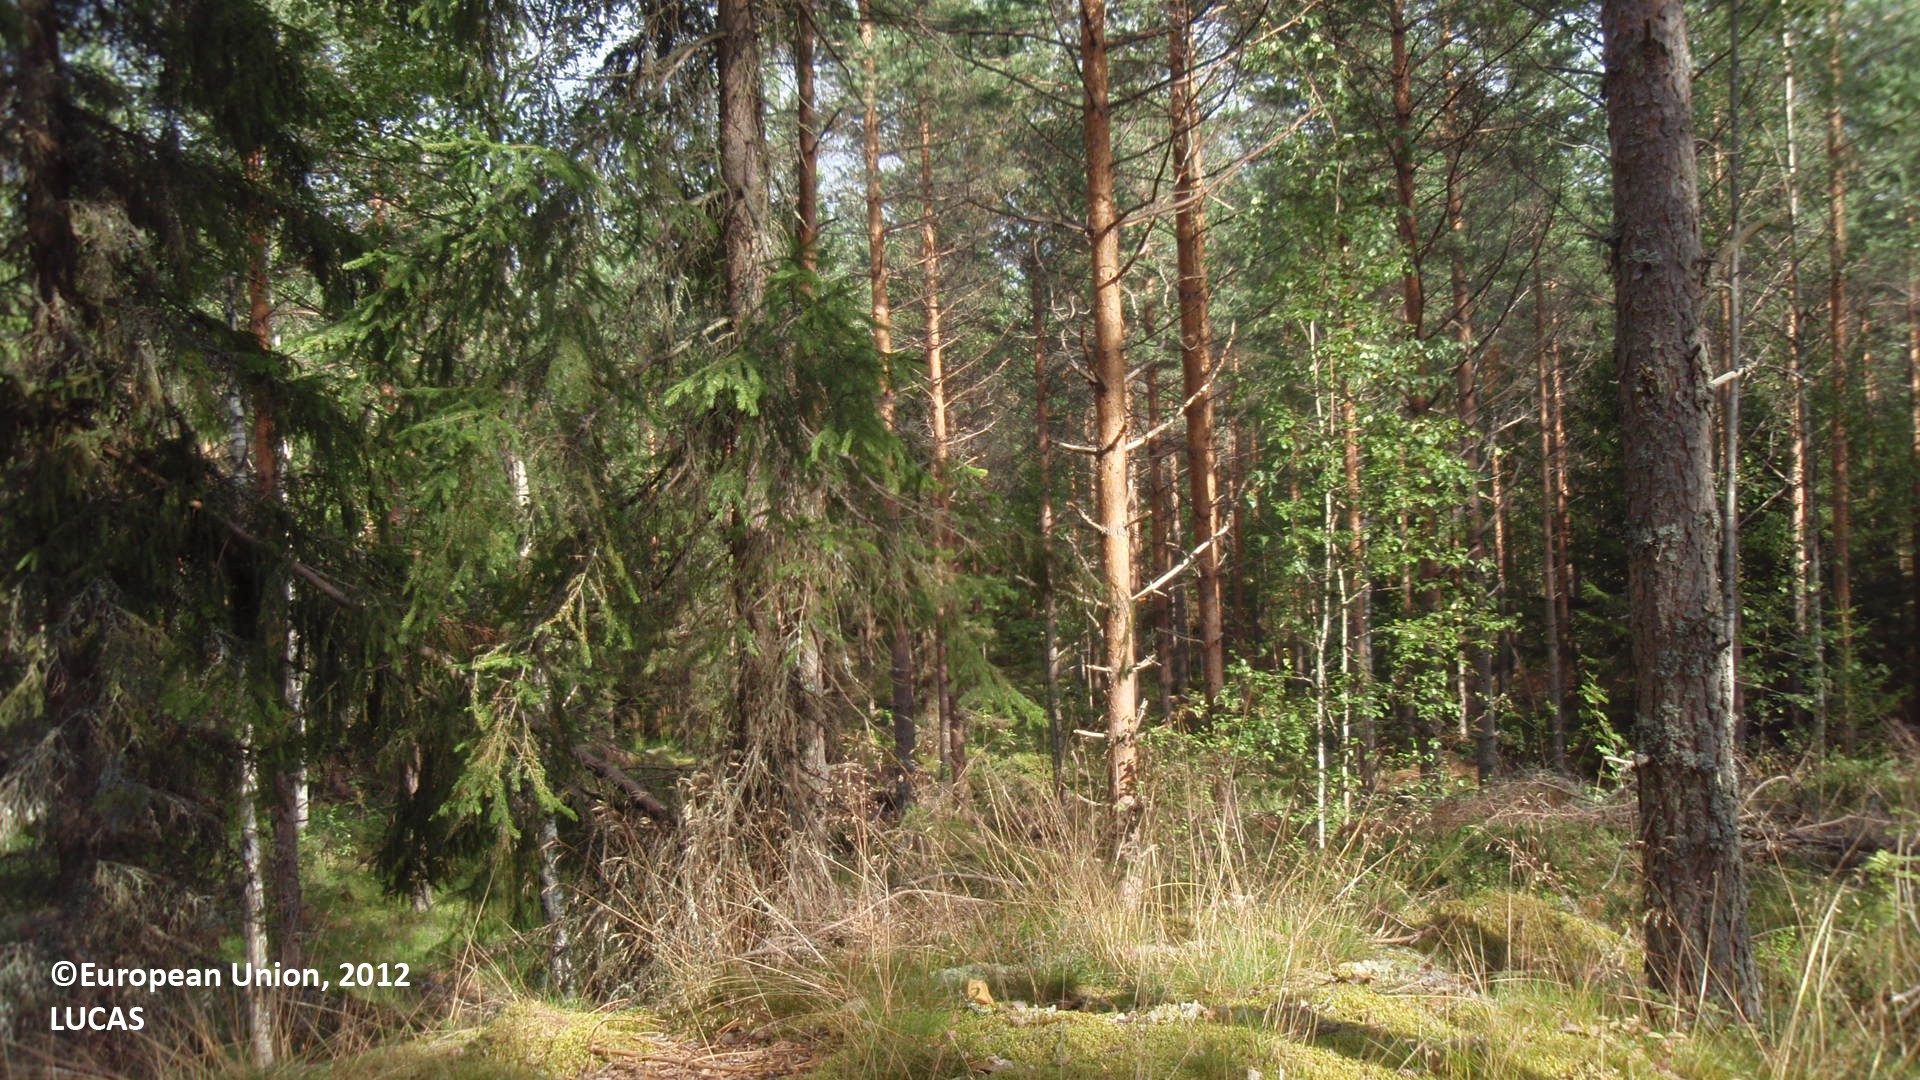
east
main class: Woodland
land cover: Pine dominated mixed woodland
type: boreal forest
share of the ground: 50 - 75 %
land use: Forestry
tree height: > 5 m
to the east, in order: Pine dominated mixed woodland; Ditches and canals; Pine dominated mixed woodland; Spruce dominated mixed woodland; Ditches and canals; Spruce dominated mixed woodland; Pine dominated mixed woodland
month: August
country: FI
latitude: 61.6329
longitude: 27.0095
